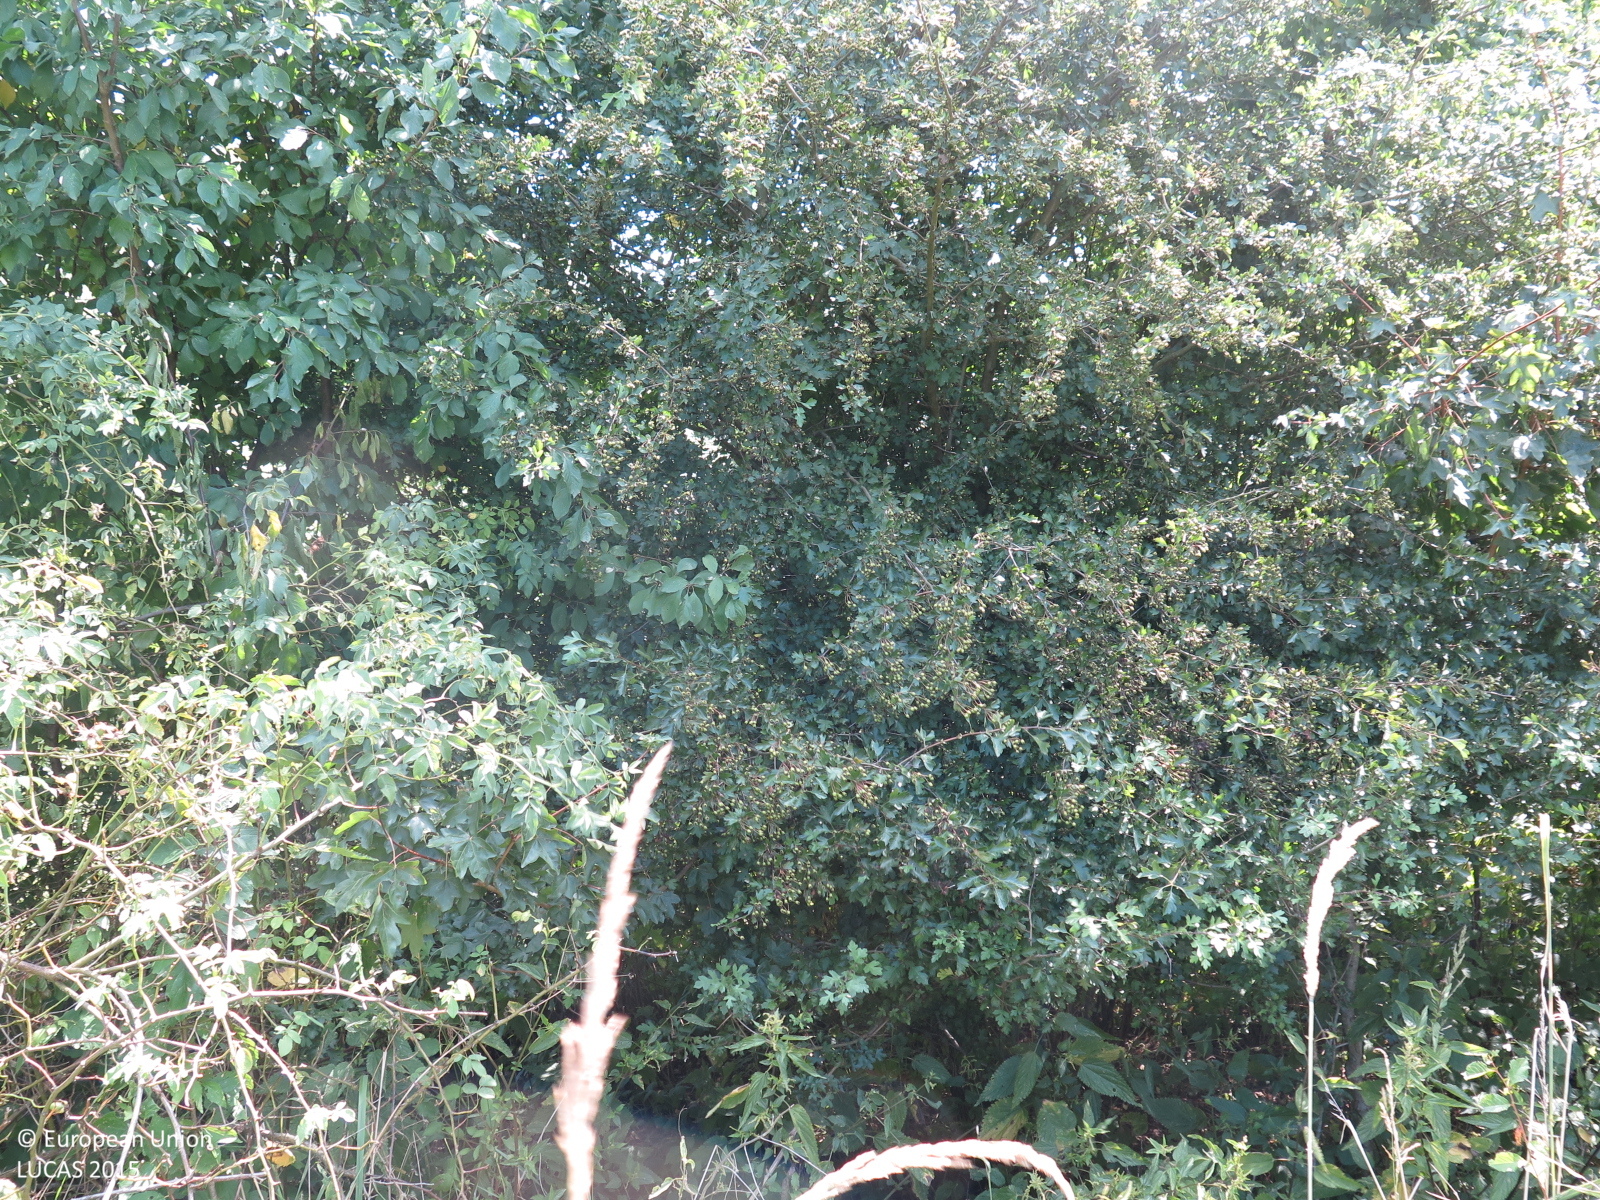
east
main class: Shrubland
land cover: Shrubland with sparse tree cover
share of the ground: > 75 %
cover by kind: shrubs 75 %, herbaceous plants 20 %, broadleaved forest trees 5 %
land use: Abandoned areas
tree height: < 5 m
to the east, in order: Shrubland with sparse tree cover; Grassland with sparse tree/shrub cover; Broadleaved woodland; Rivers and streams; Broadleaved woodland; Grassland without tree/shrub cover; Ditches and canals; Grassland with sparse tree/shrub cover; Other bare soil
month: July
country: CZ
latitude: 48.9216
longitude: 17.5587
